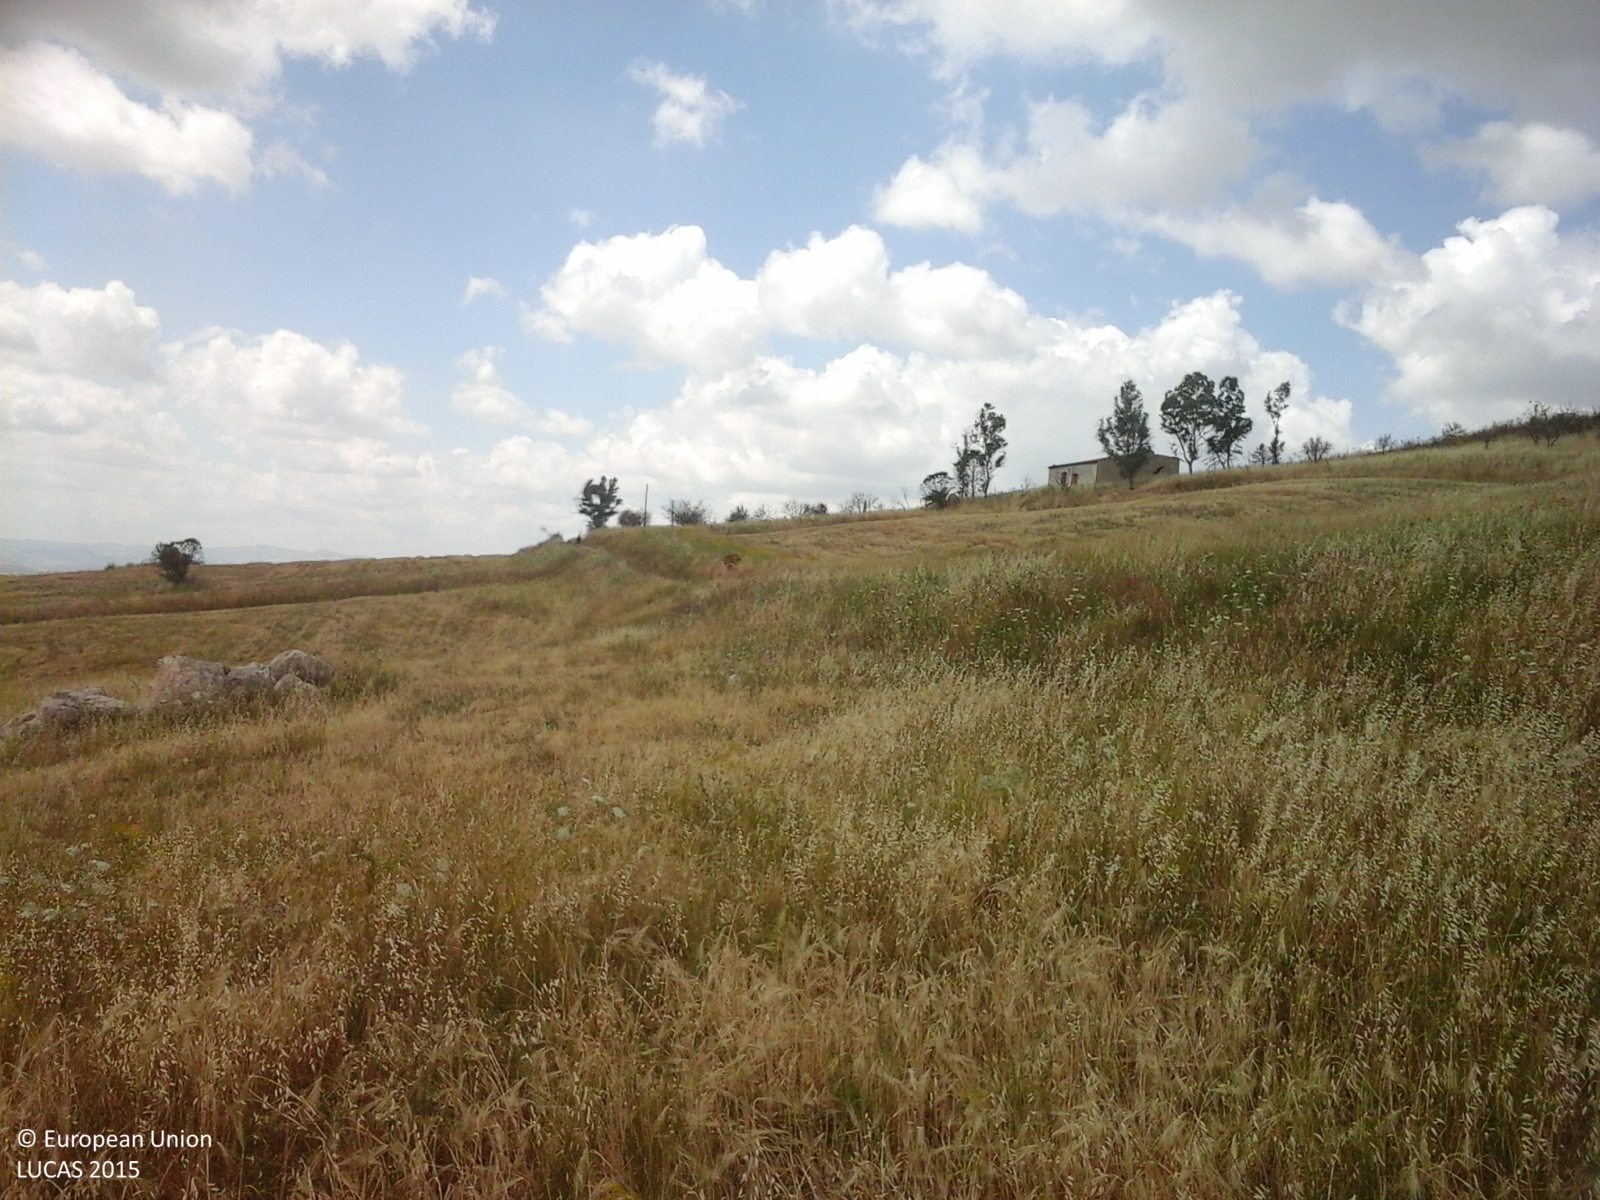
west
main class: Cropland
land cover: Durum wheat
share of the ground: > 75 %
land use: Agriculture (excluding fallow land and kitchen gardens)
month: June
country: IT
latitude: 37.6594
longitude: 13.1391
